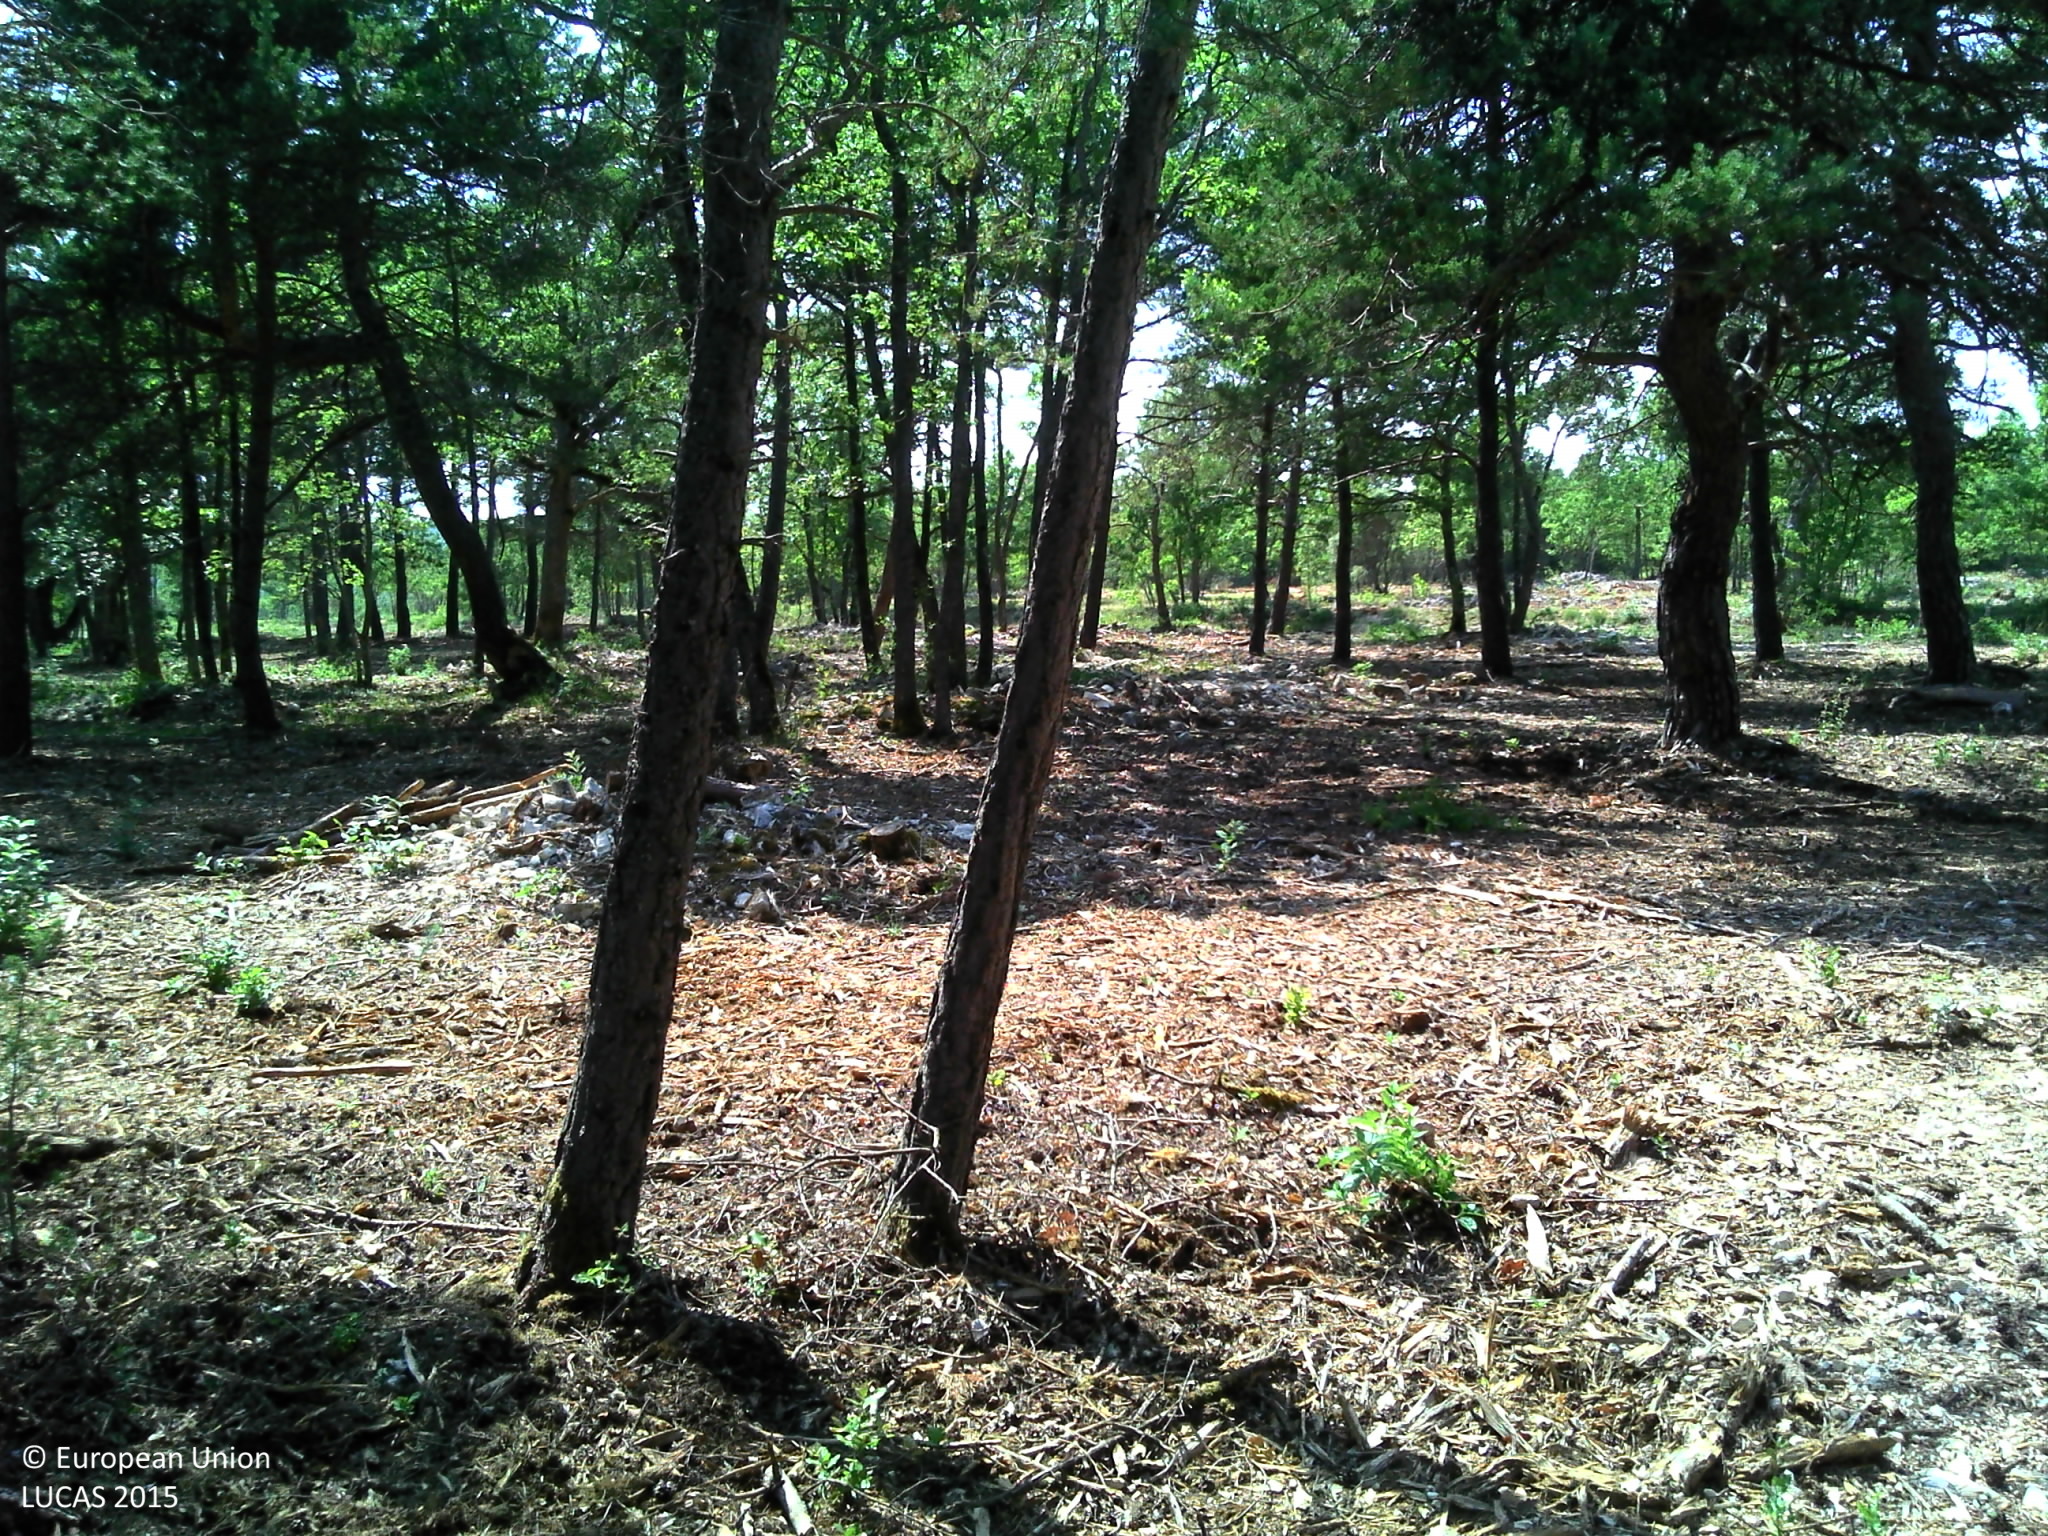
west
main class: Woodland
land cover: Pine dominated mixed woodland
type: mesophytic deciduous forest
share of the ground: > 75 %
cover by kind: coniferous forest trees 35 %, broadleaved forest trees 20 %, shrubs 20 %, unconsolidated bare surface 20 %, herbaceous plants 5 %
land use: Forestry
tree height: > 5 m
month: July
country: FR
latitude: 44.0118
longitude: 5.3558
